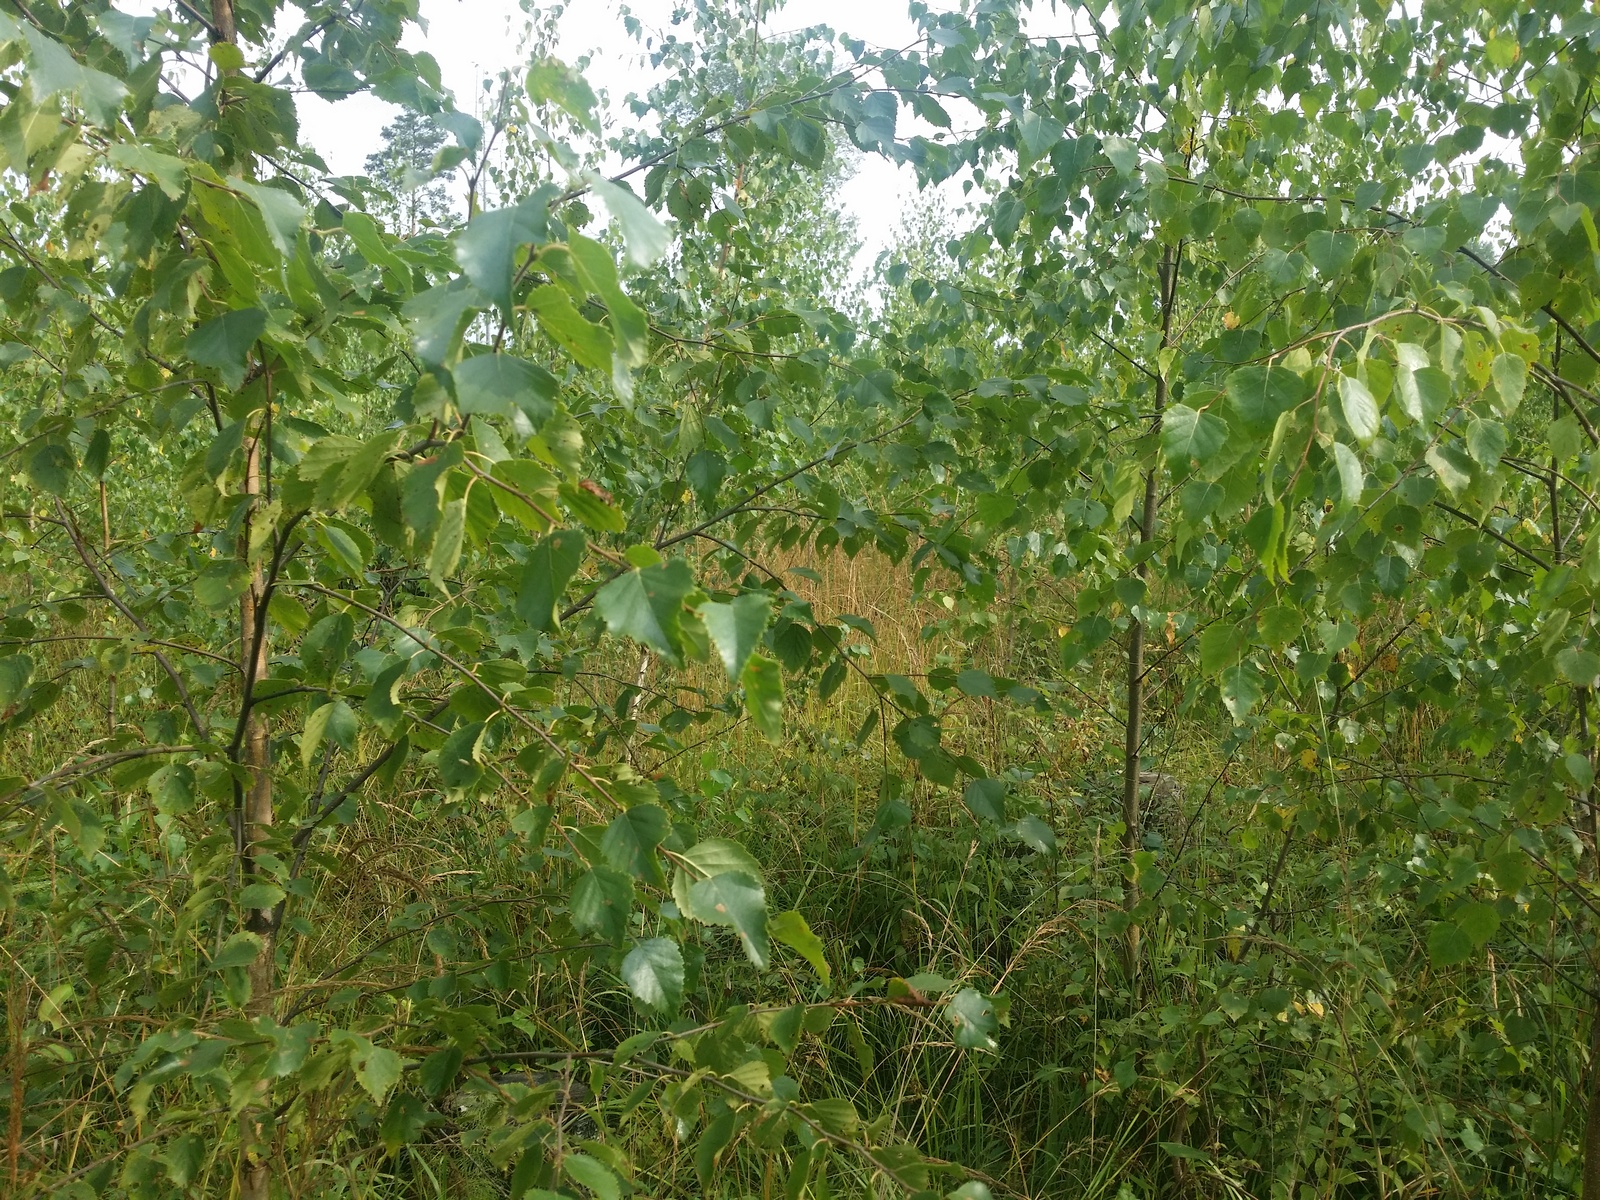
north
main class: Woodland
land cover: Broadleaved woodland
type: non-riverine alder, birch or aspen forest
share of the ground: 50 - 75 %
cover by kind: broadleaved forest trees 70 %, shrubs 20 %, herbaceous plants 10 %
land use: Forestry
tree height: < 5 m
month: August
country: LV
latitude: 57.4827
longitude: 26.5052
